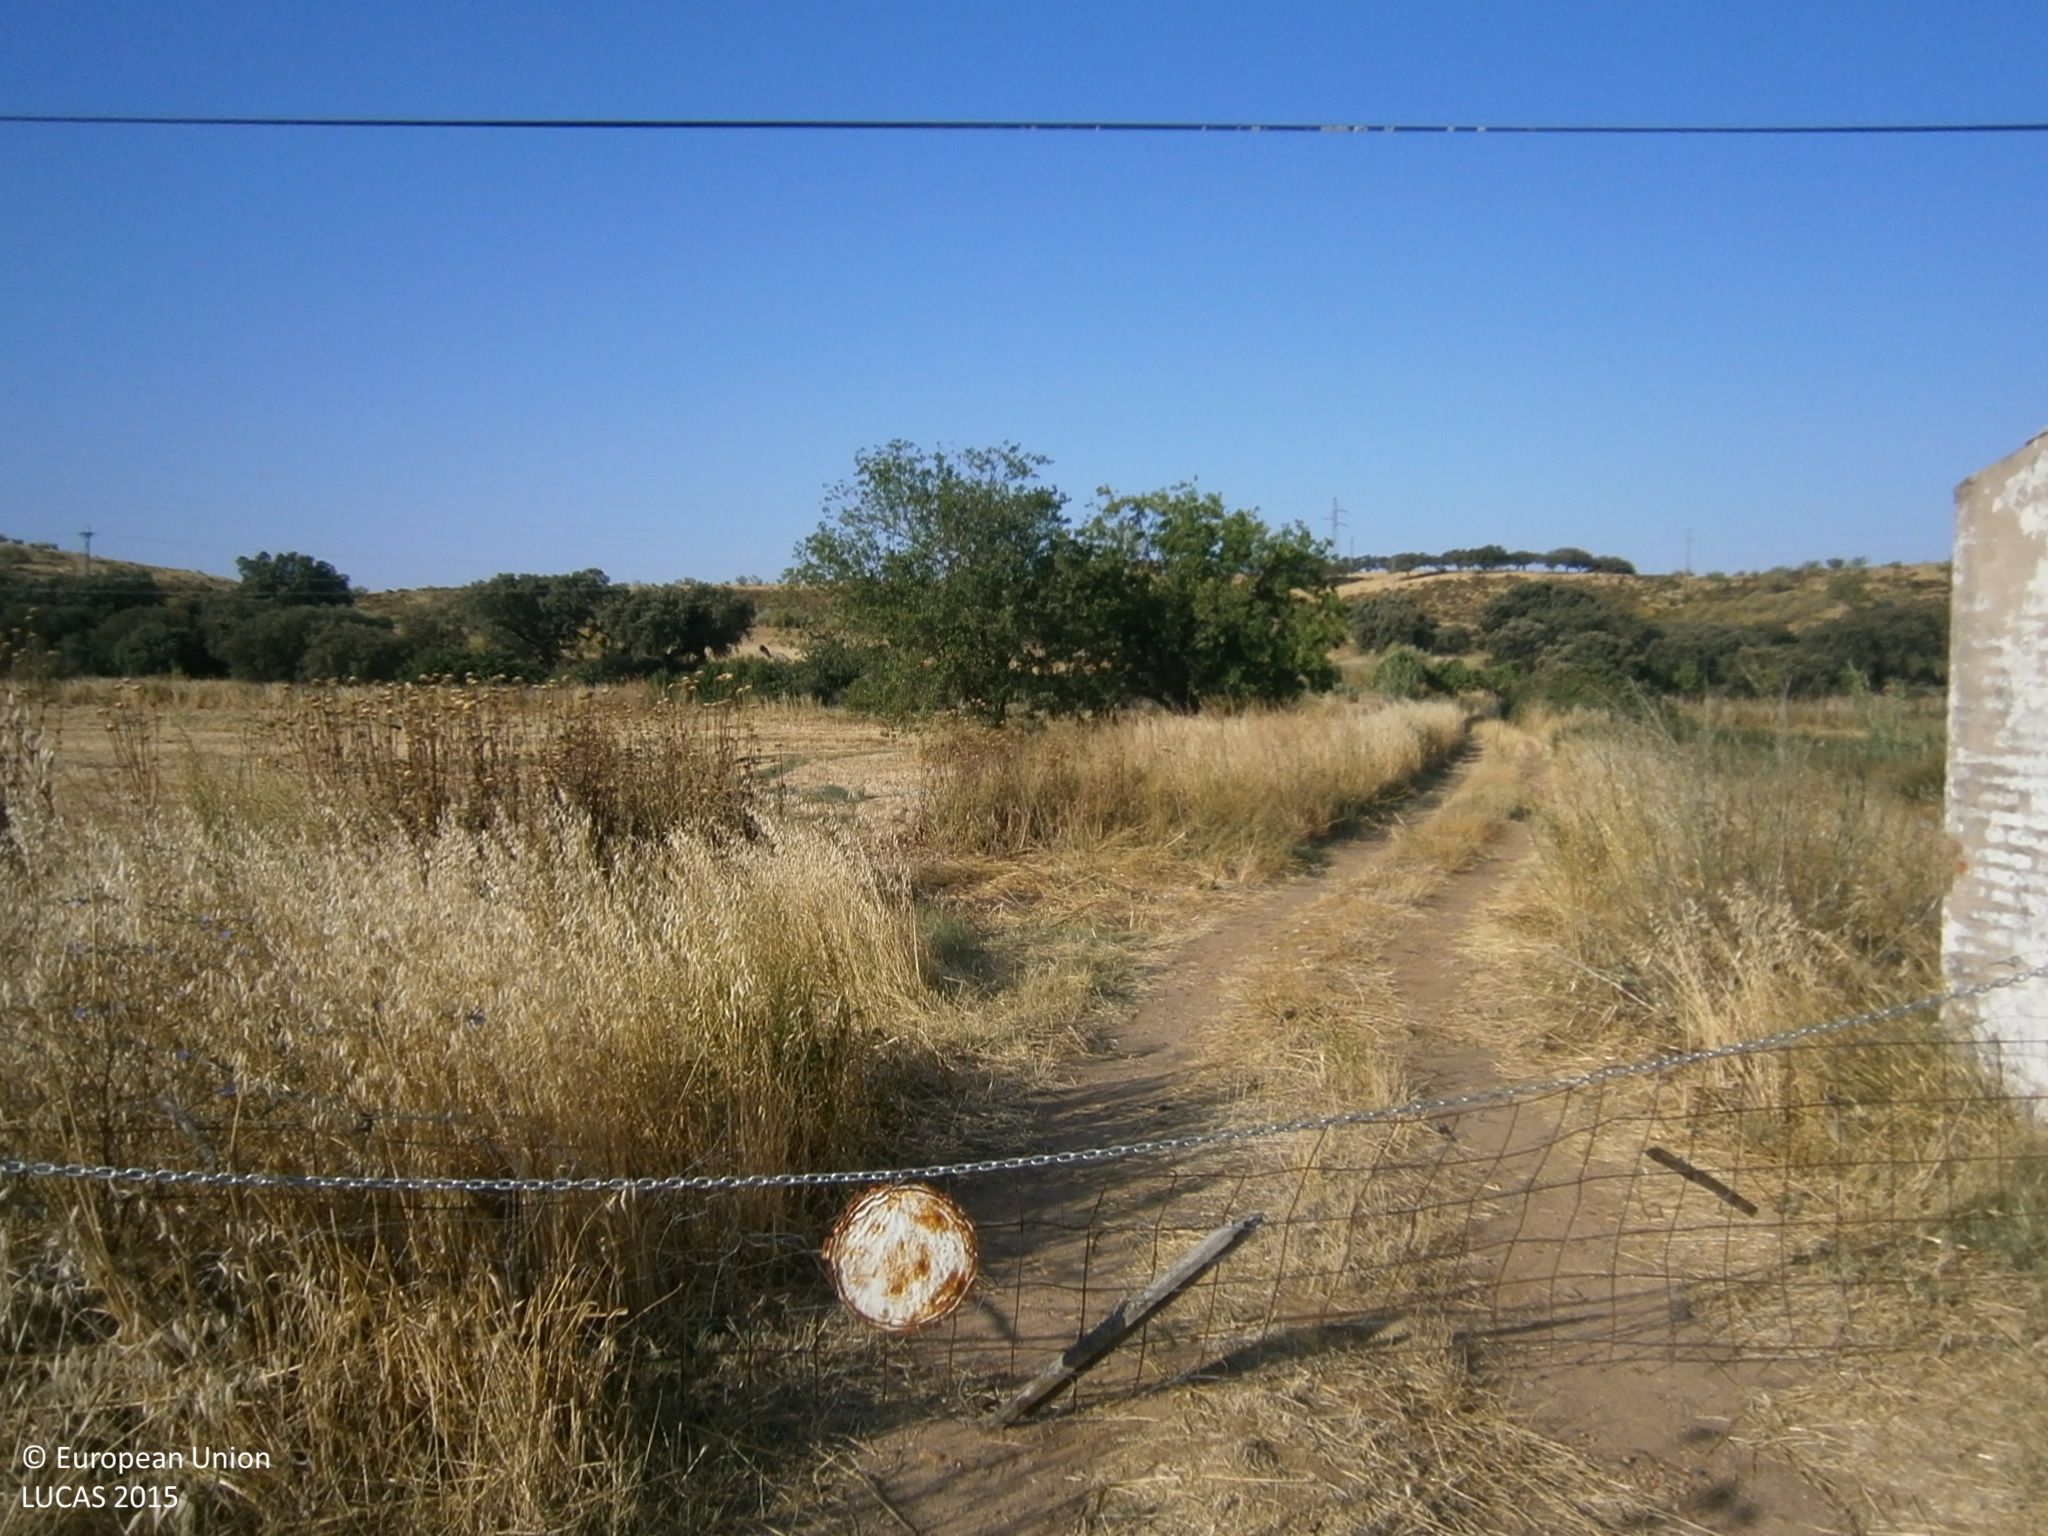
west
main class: Cropland
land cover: Oats
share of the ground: > 75 %
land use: Agriculture (excluding fallow land and kitchen gardens)
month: June
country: ES
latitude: 38.8092
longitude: -6.8915
